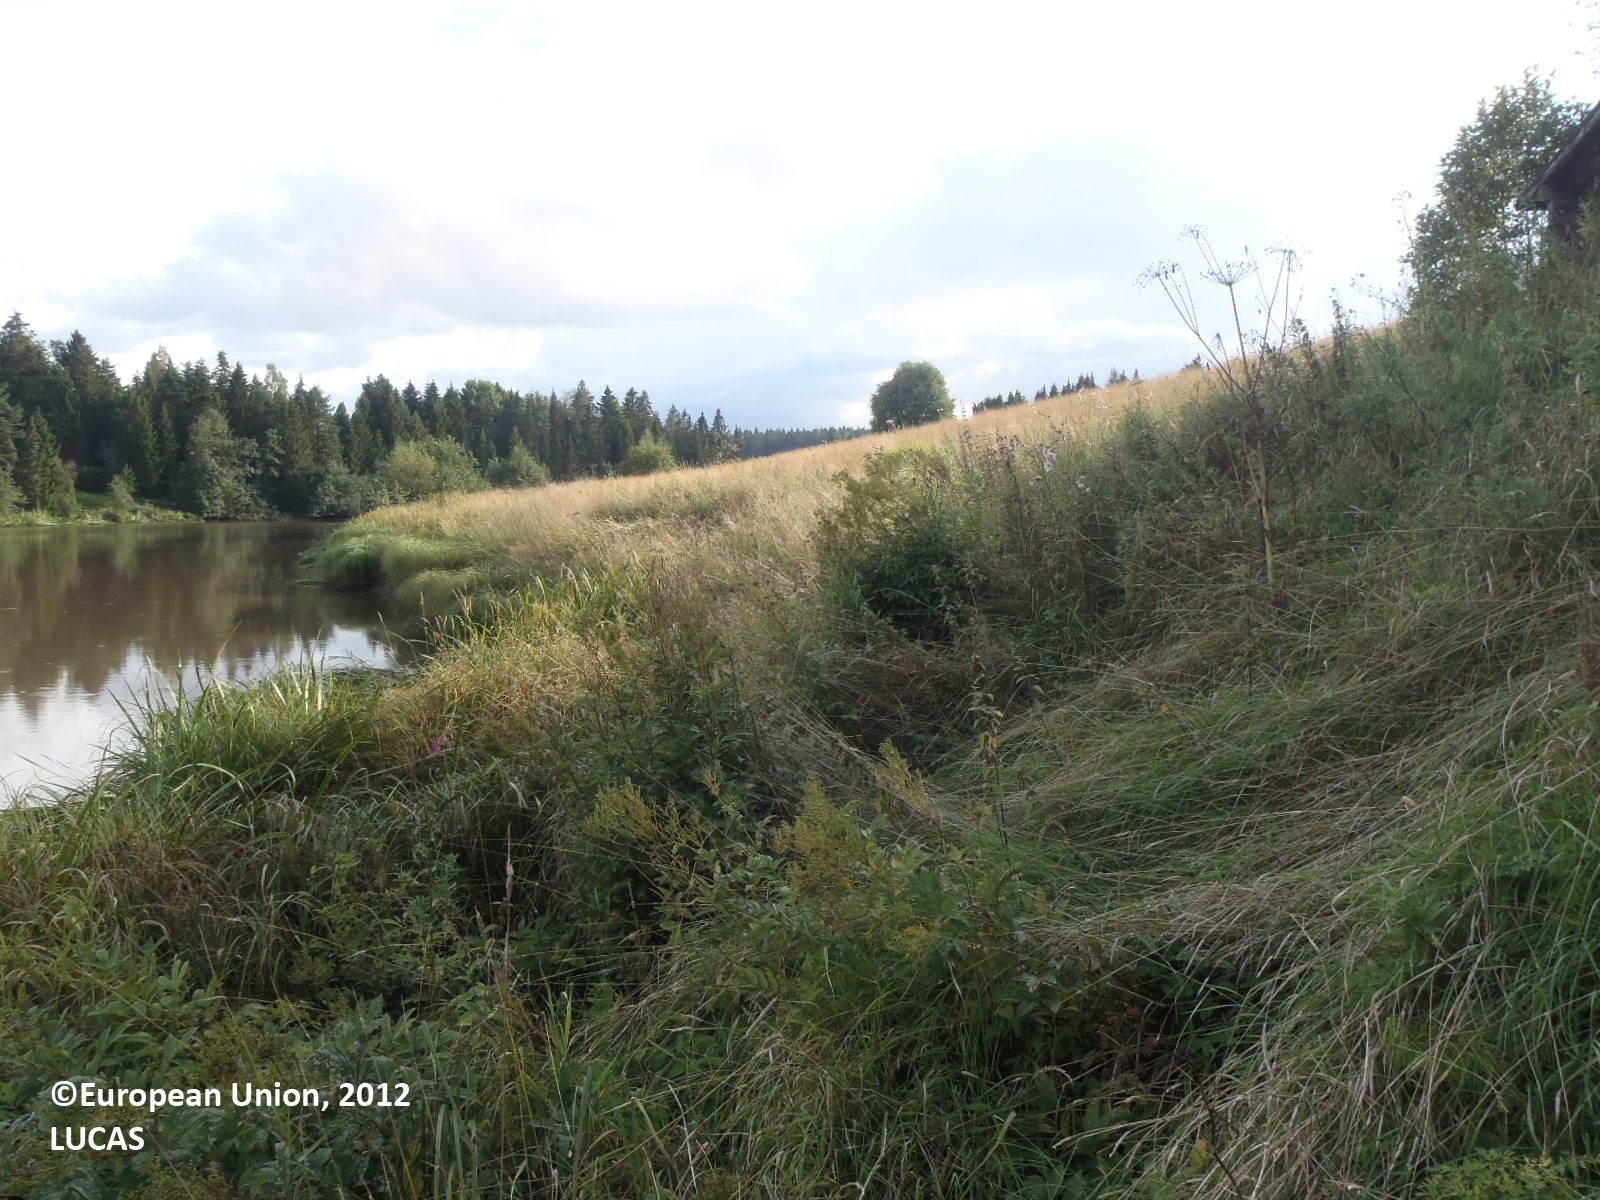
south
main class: Grassland
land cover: Grassland without tree/shrub cover
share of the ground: > 75 %
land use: Agriculture (excluding fallow land and kitchen gardens)
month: August
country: FI
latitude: 60.5352
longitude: 22.7032
